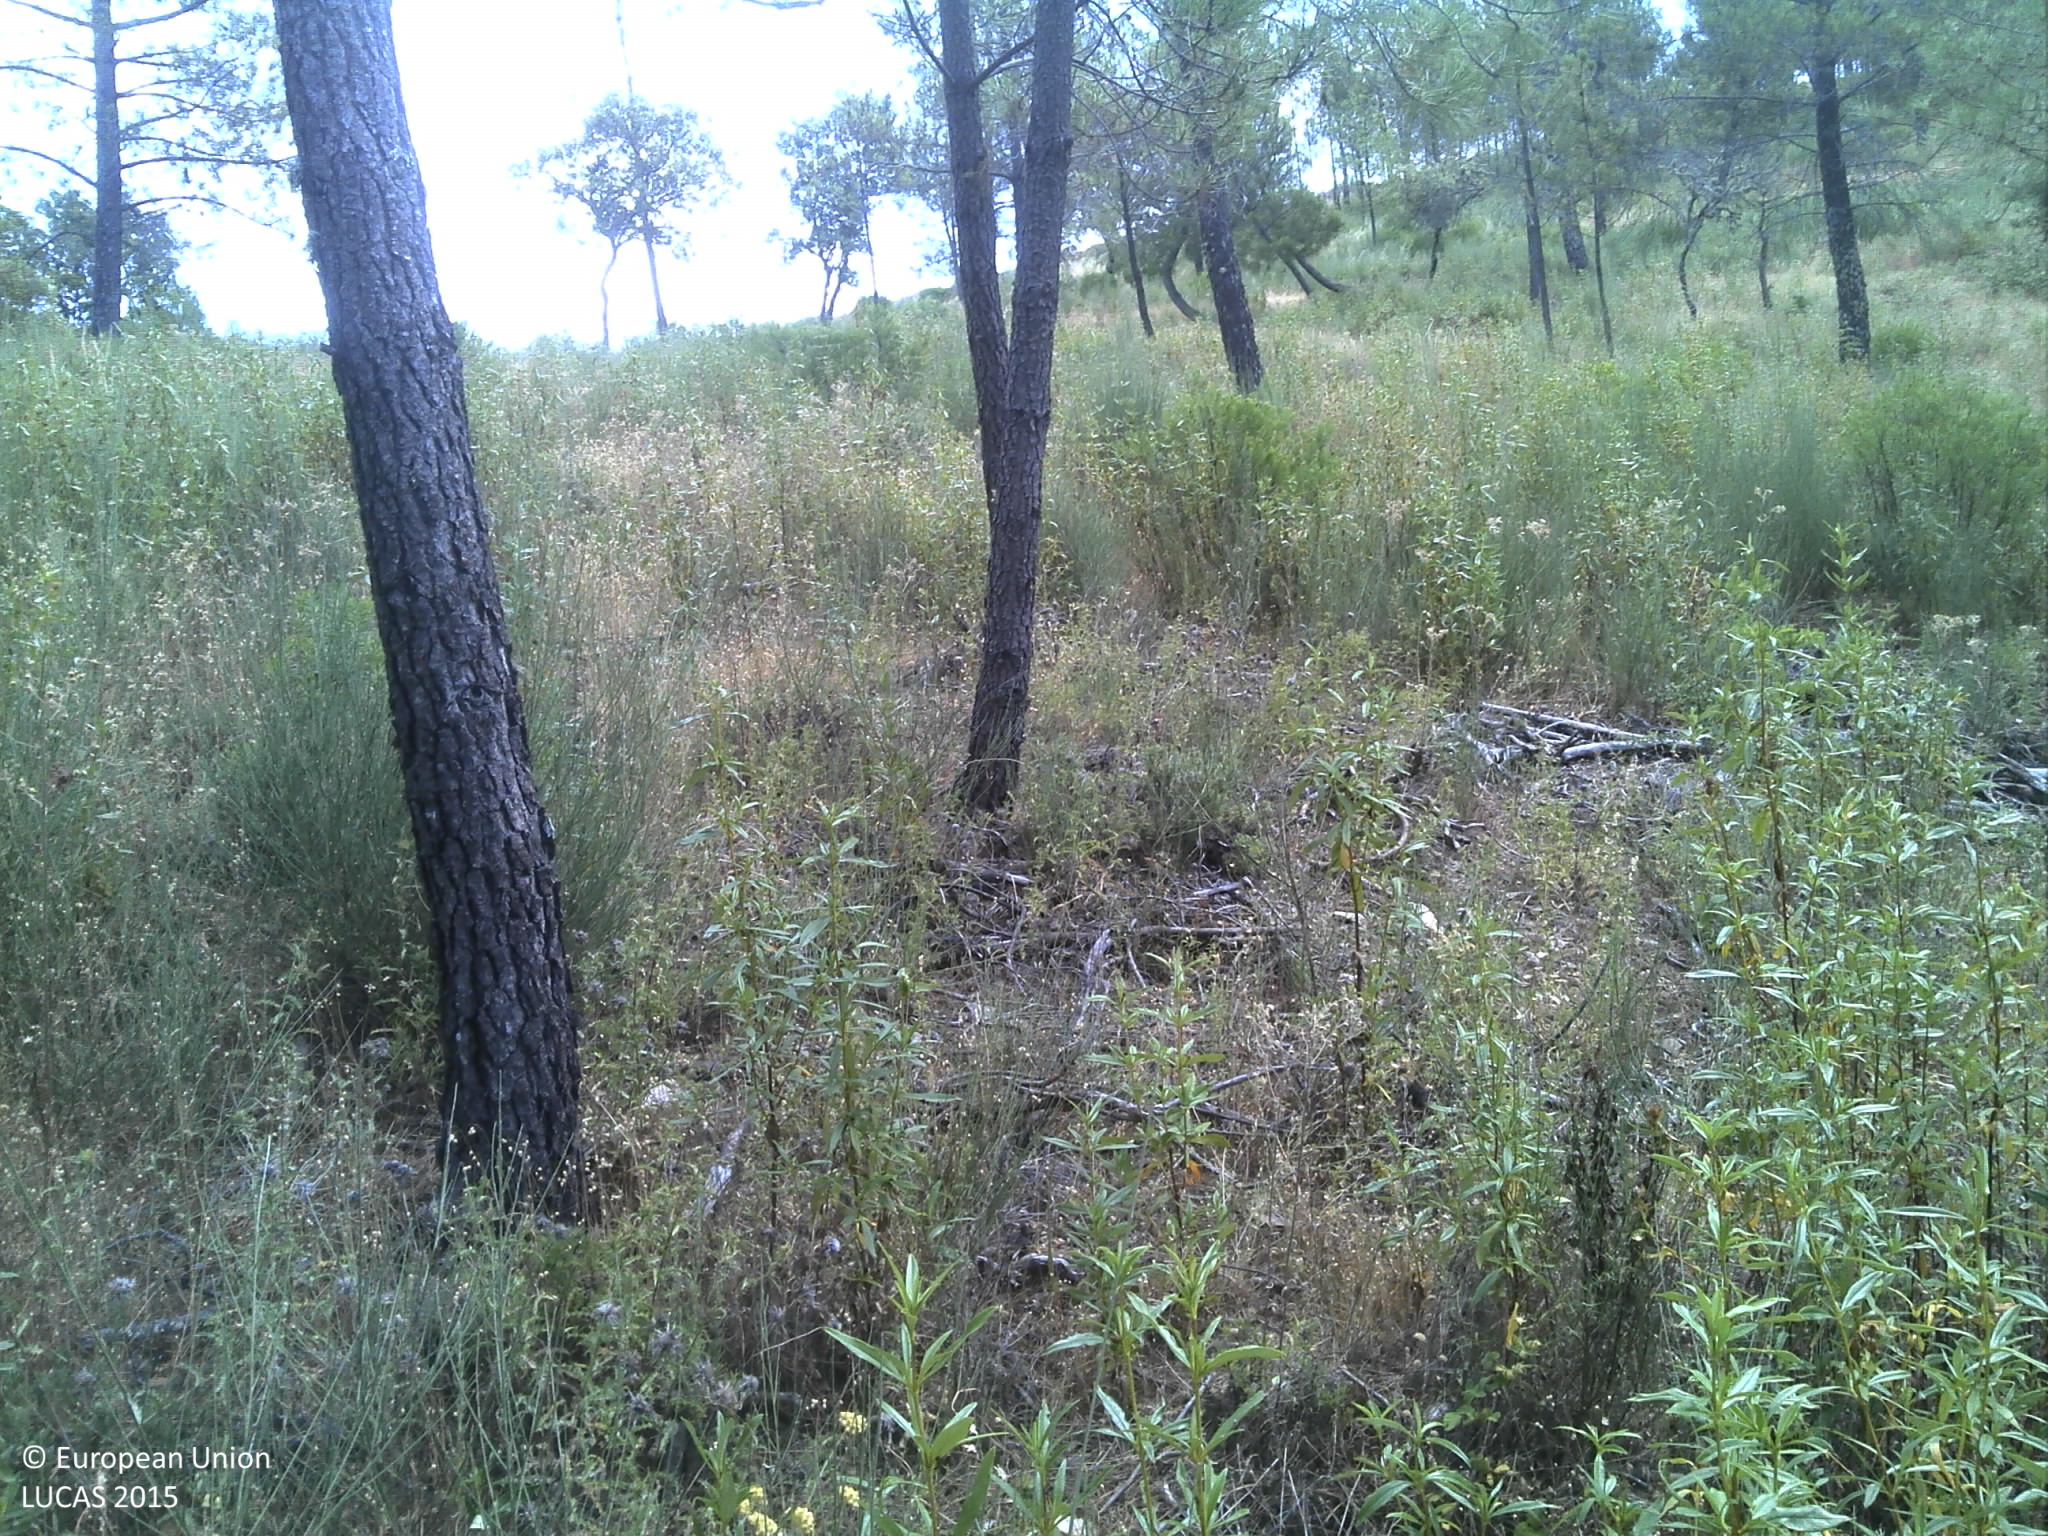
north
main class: Woodland
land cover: Pine dominated coniferous woodland
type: coniferous forest of the mediterranean region
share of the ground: 25 - 50 %
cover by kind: coniferous forest trees 45 %, shrubs 35 %, unconsolidated bare surface 20 %
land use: Forestry
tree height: > 5 m
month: June
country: PT
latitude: 40.1986
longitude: -7.1666
